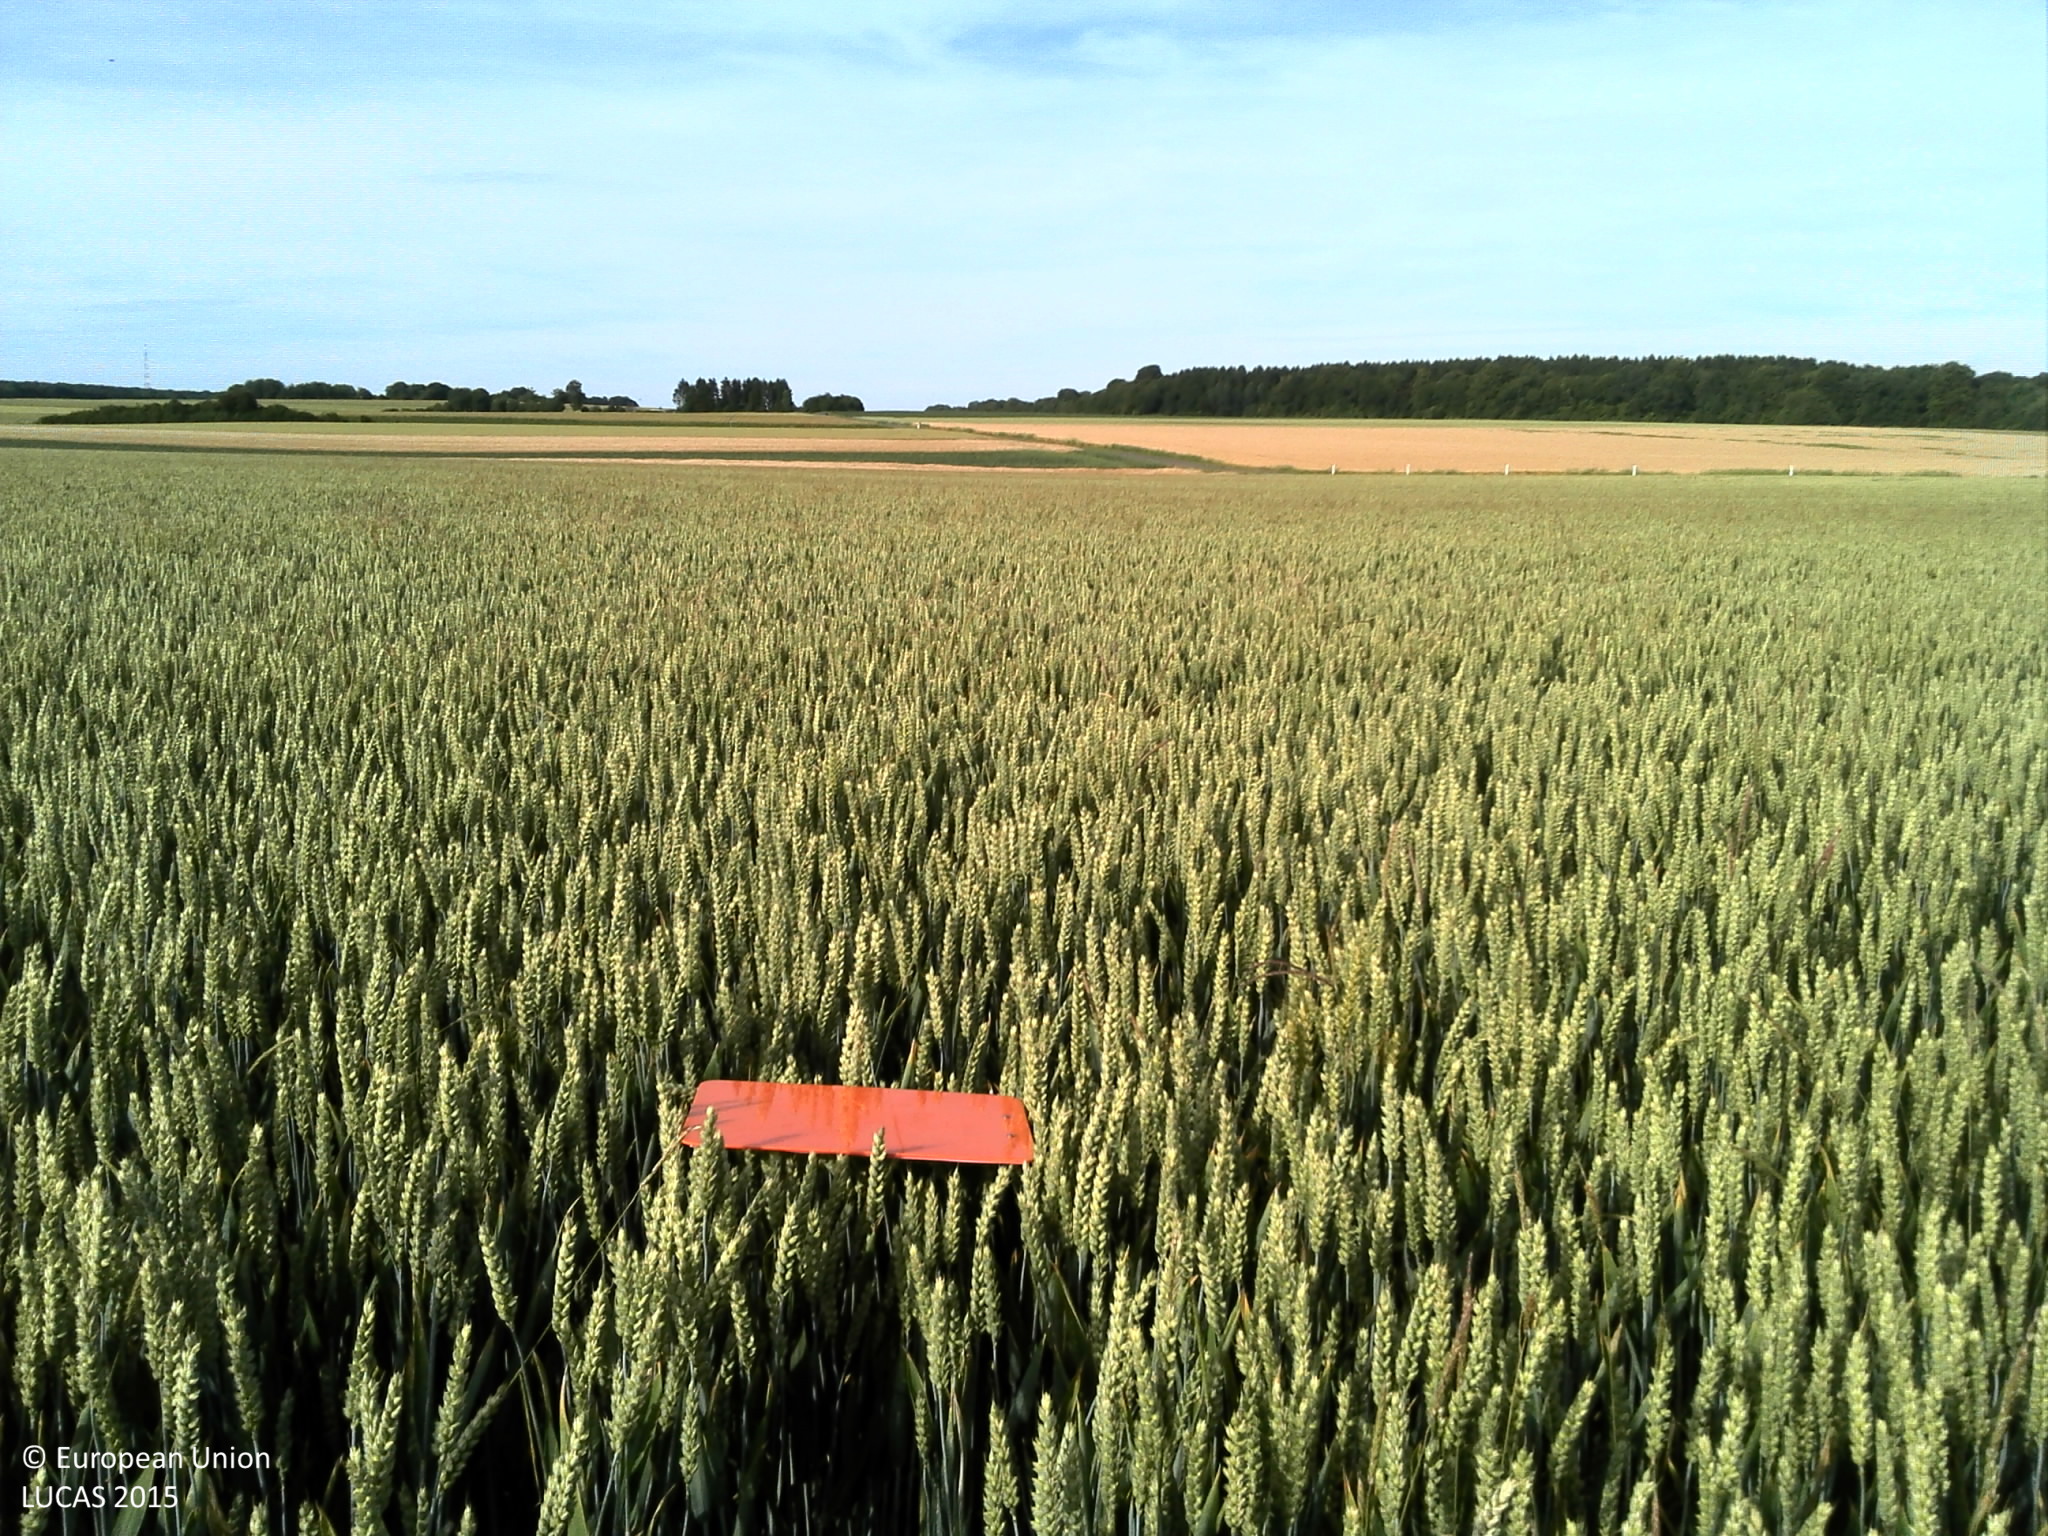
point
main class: Cropland
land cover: Common wheat
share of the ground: > 75 %
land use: Agriculture (excluding fallow land and kitchen gardens)
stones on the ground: < 10 %
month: June
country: FR
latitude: 49.3954
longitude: 6.0450
